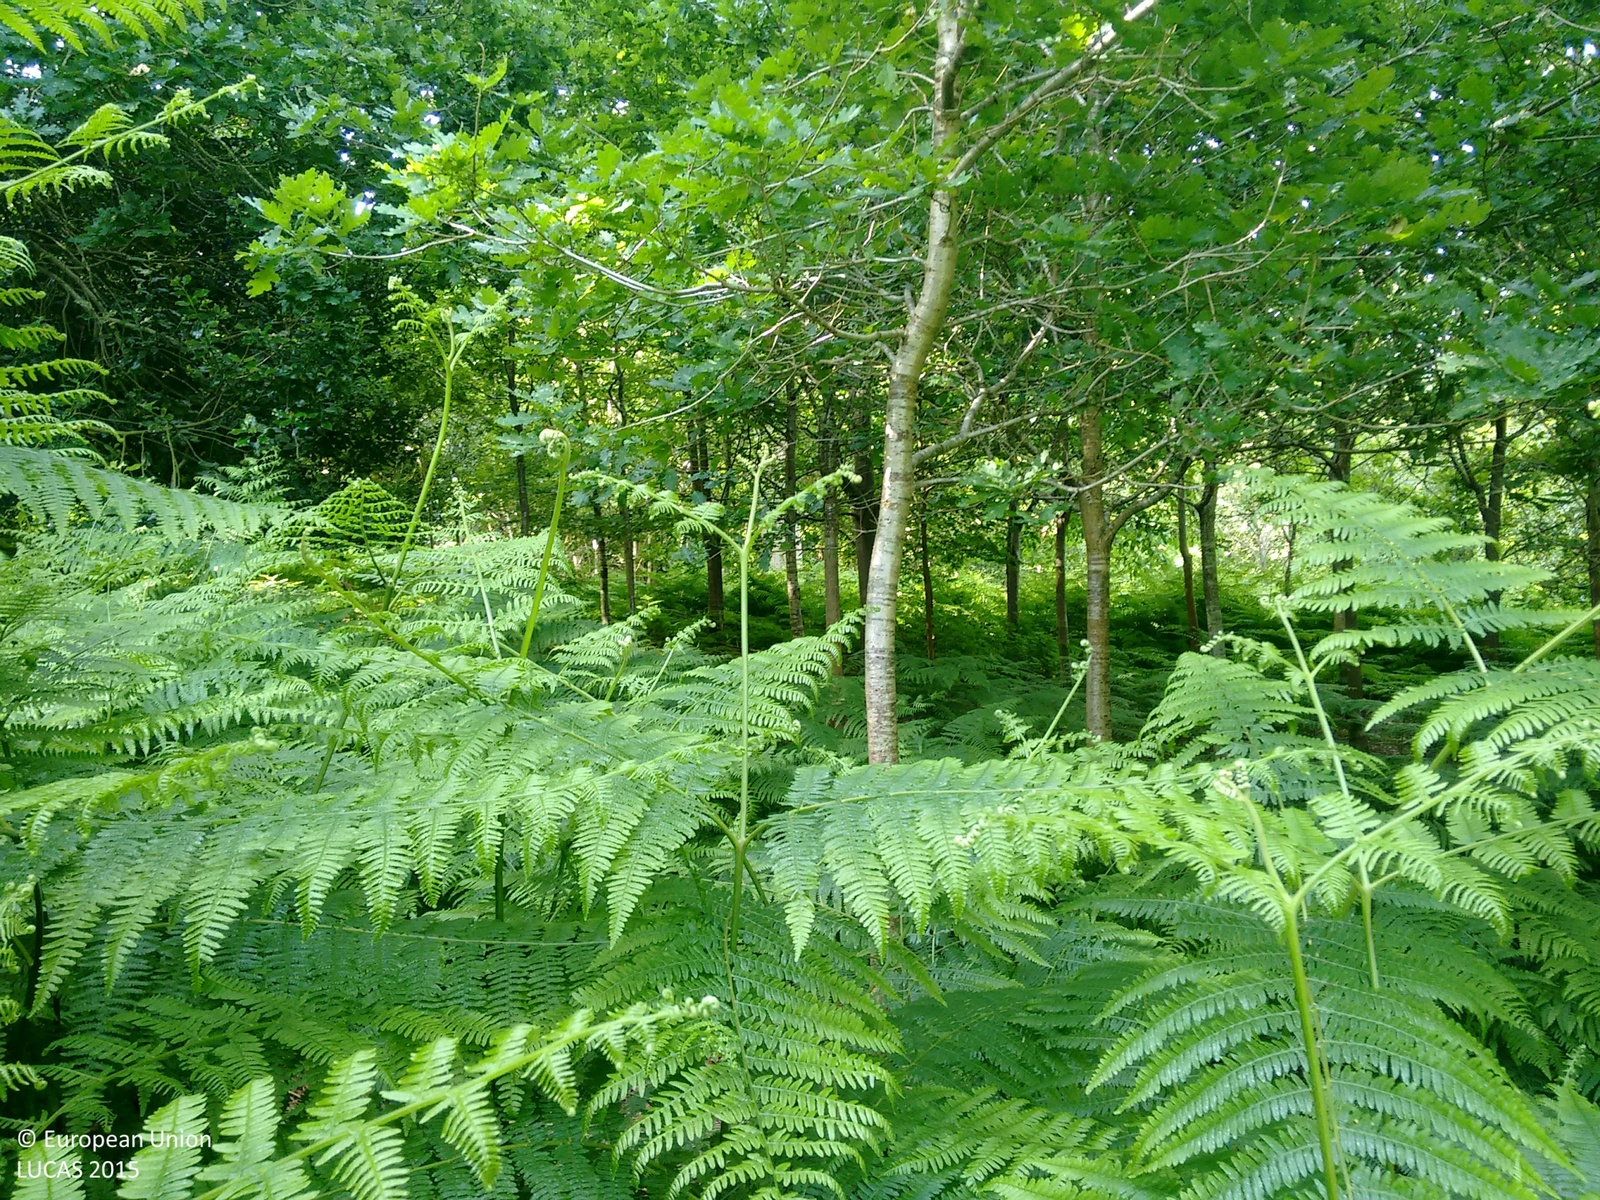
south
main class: Woodland
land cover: Broadleaved woodland
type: mesophytic deciduous forest
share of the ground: 50 - 75 %
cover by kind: broadleaved forest trees 70 %, herbaceous plants 20 %, shrubs 10 %
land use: Forestry
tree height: > 5 m
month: June
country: GB
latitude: 50.9012
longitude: 0.4016
